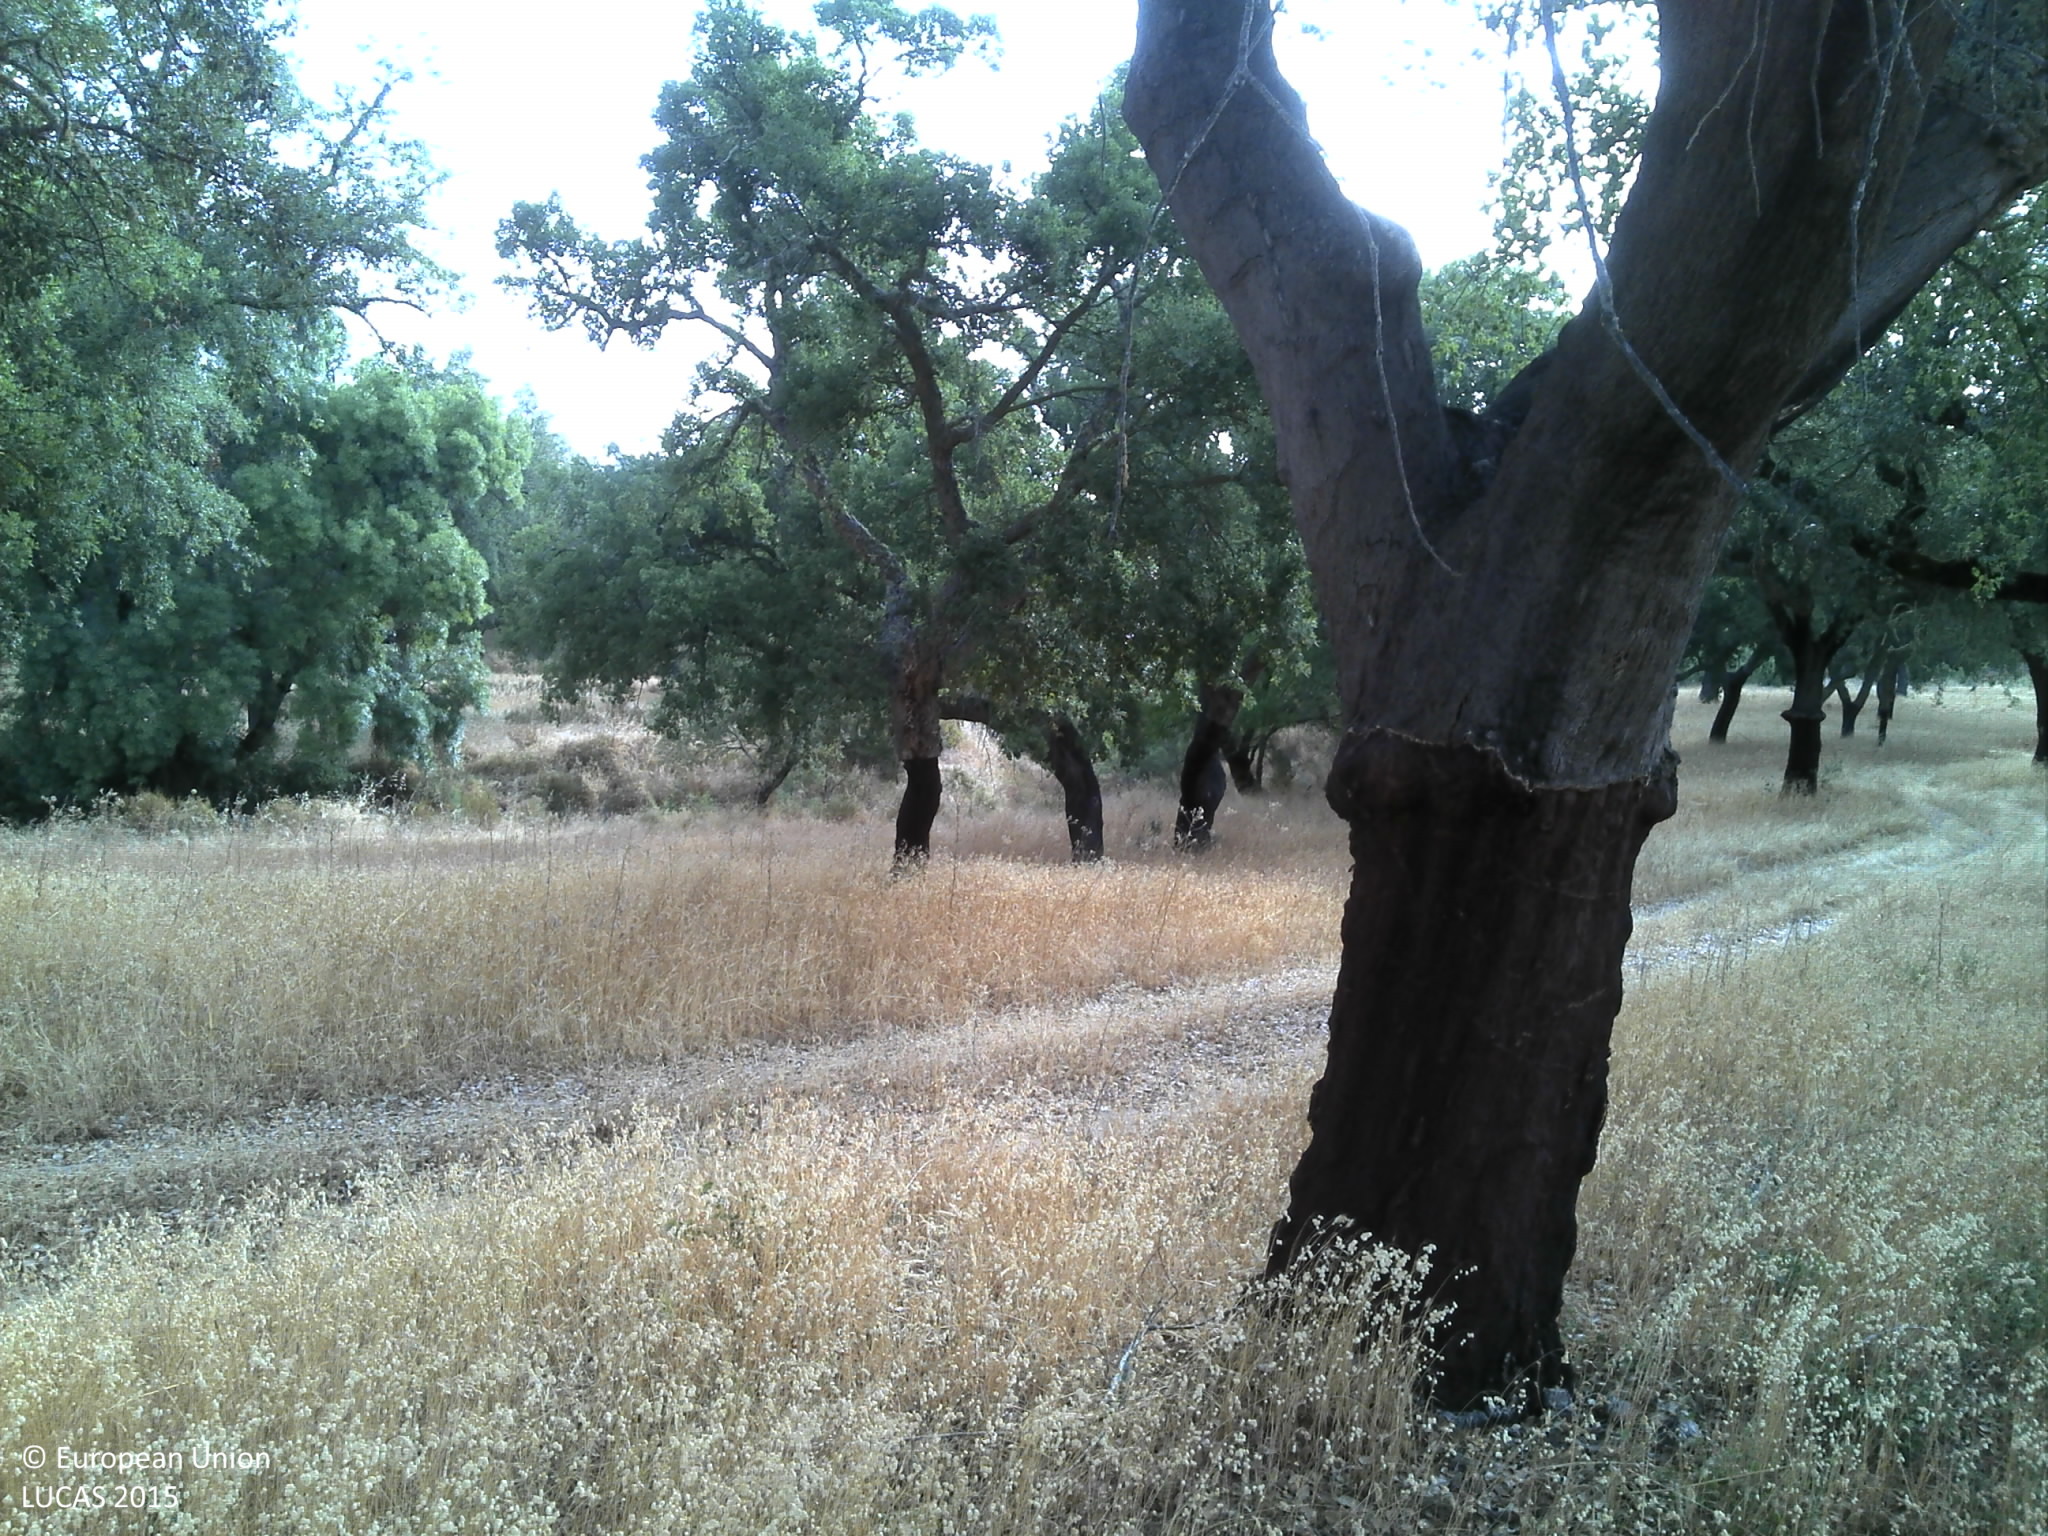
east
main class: Woodland
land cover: Broadleaved woodland
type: broadleaved evergreen forest
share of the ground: 25 - 50 %
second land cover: Grassland without tree/shrub cover
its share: 25 - 50 %
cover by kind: herbaceous plants 50 %, broadleaved forest trees 30 %, unconsolidated bare surface 20 %
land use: Forestry
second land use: Agriculture (excluding fallow land and kitchen gardens)
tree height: > 5 m
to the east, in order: Broadleaved woodland; Grassland without tree/shrub cover; Broadleaved woodland; Tracks; Broadleaved woodland; Inland fresh running water; Abandoned hedges; Fences; Broadleaved woodland
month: July
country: PT
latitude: 38.7281
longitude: -7.7412
